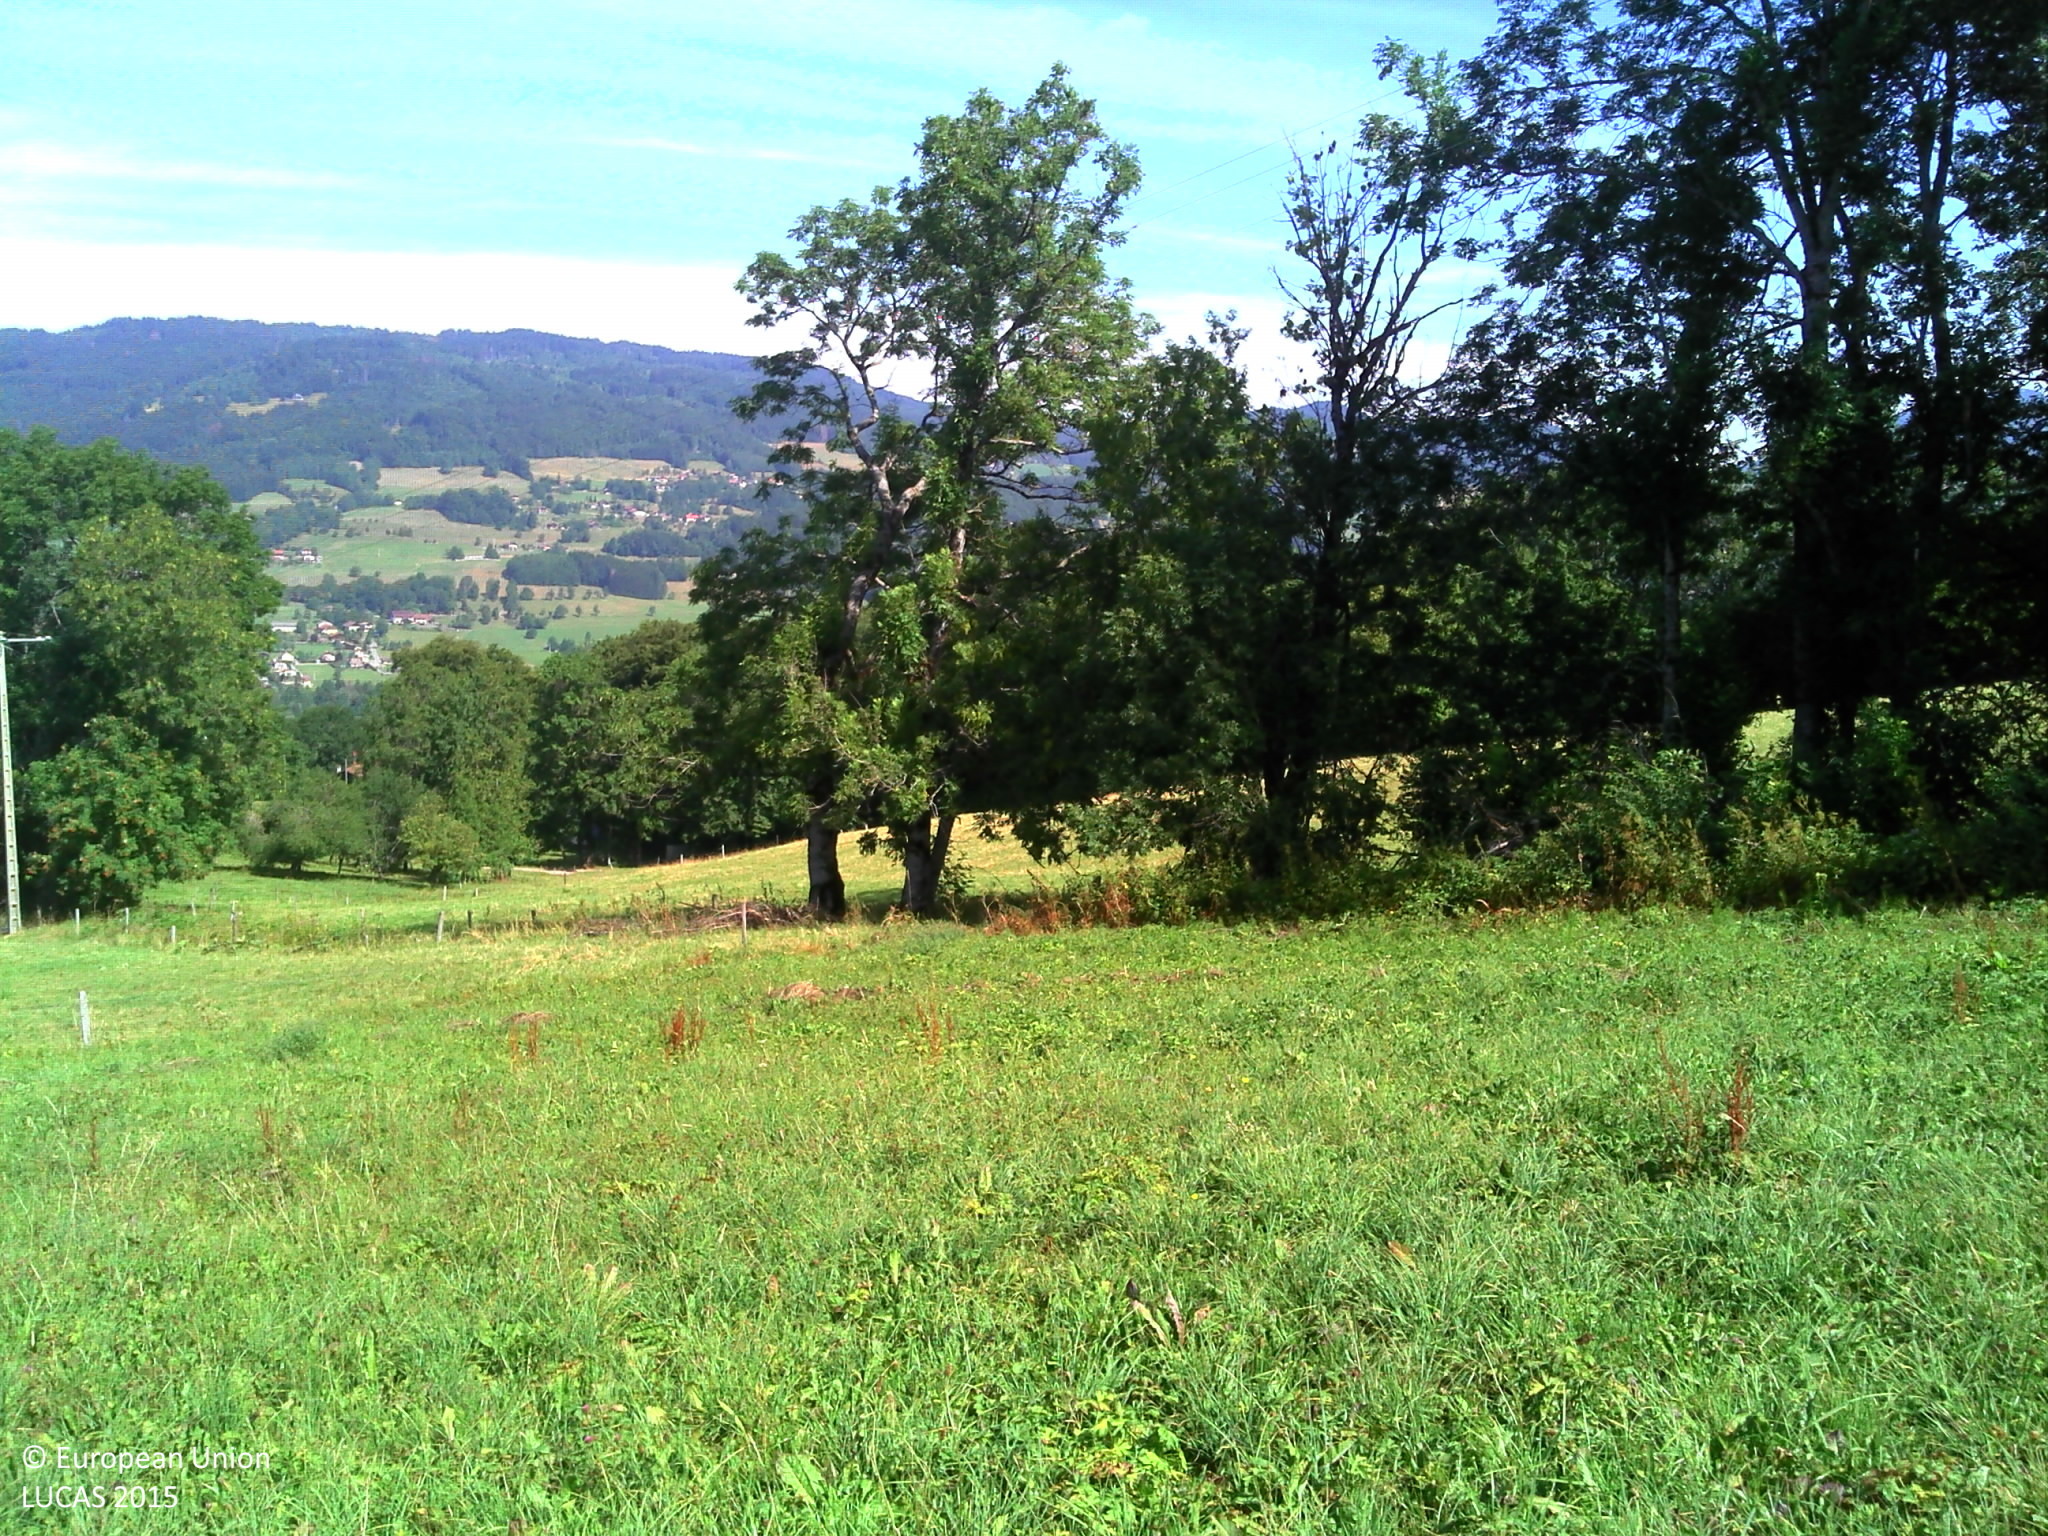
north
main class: Grassland
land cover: Grassland without tree/shrub cover
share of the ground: > 75 %
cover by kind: herbaceous plants 100 %
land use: Agriculture (excluding fallow land and kitchen gardens)
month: July
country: FR
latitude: 46.2018
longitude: 6.4396
